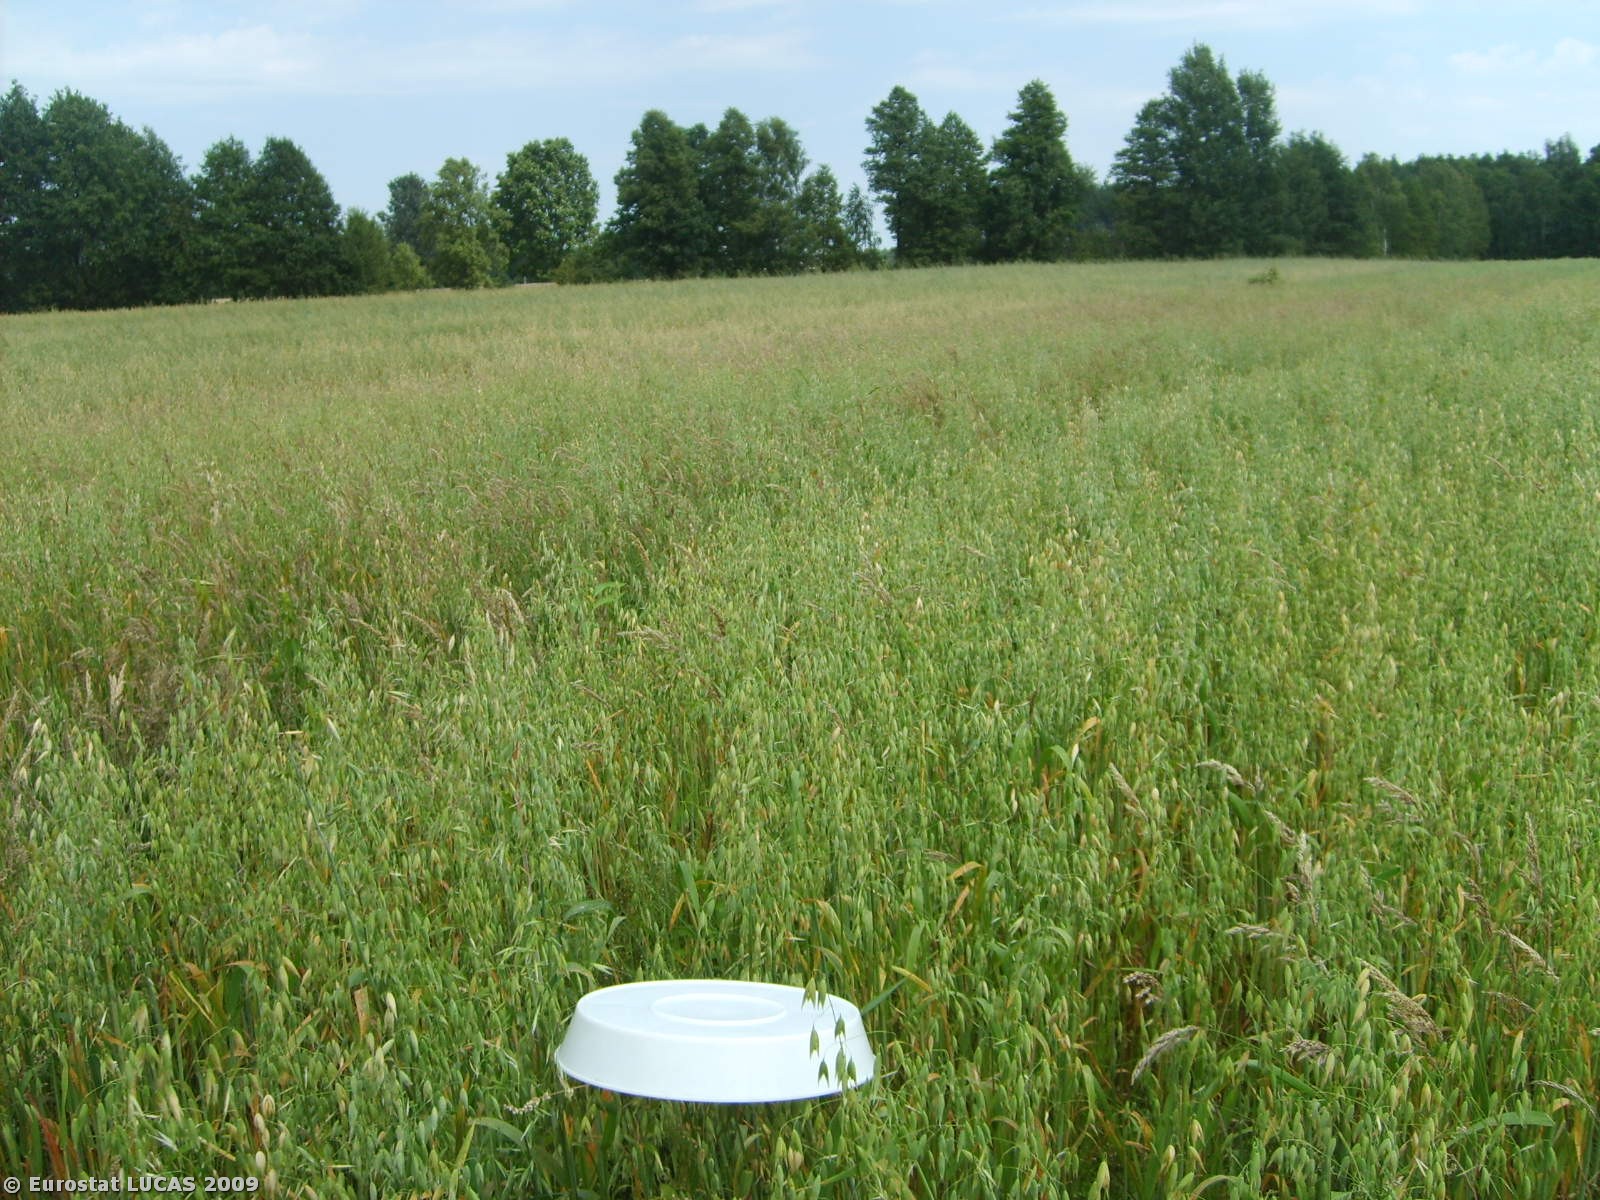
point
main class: Cropland
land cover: Oats
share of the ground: > 75 %
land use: Agriculture (excluding fallow land and kitchen gardens)
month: July
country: PL
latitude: 52.4544
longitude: 21.6638
